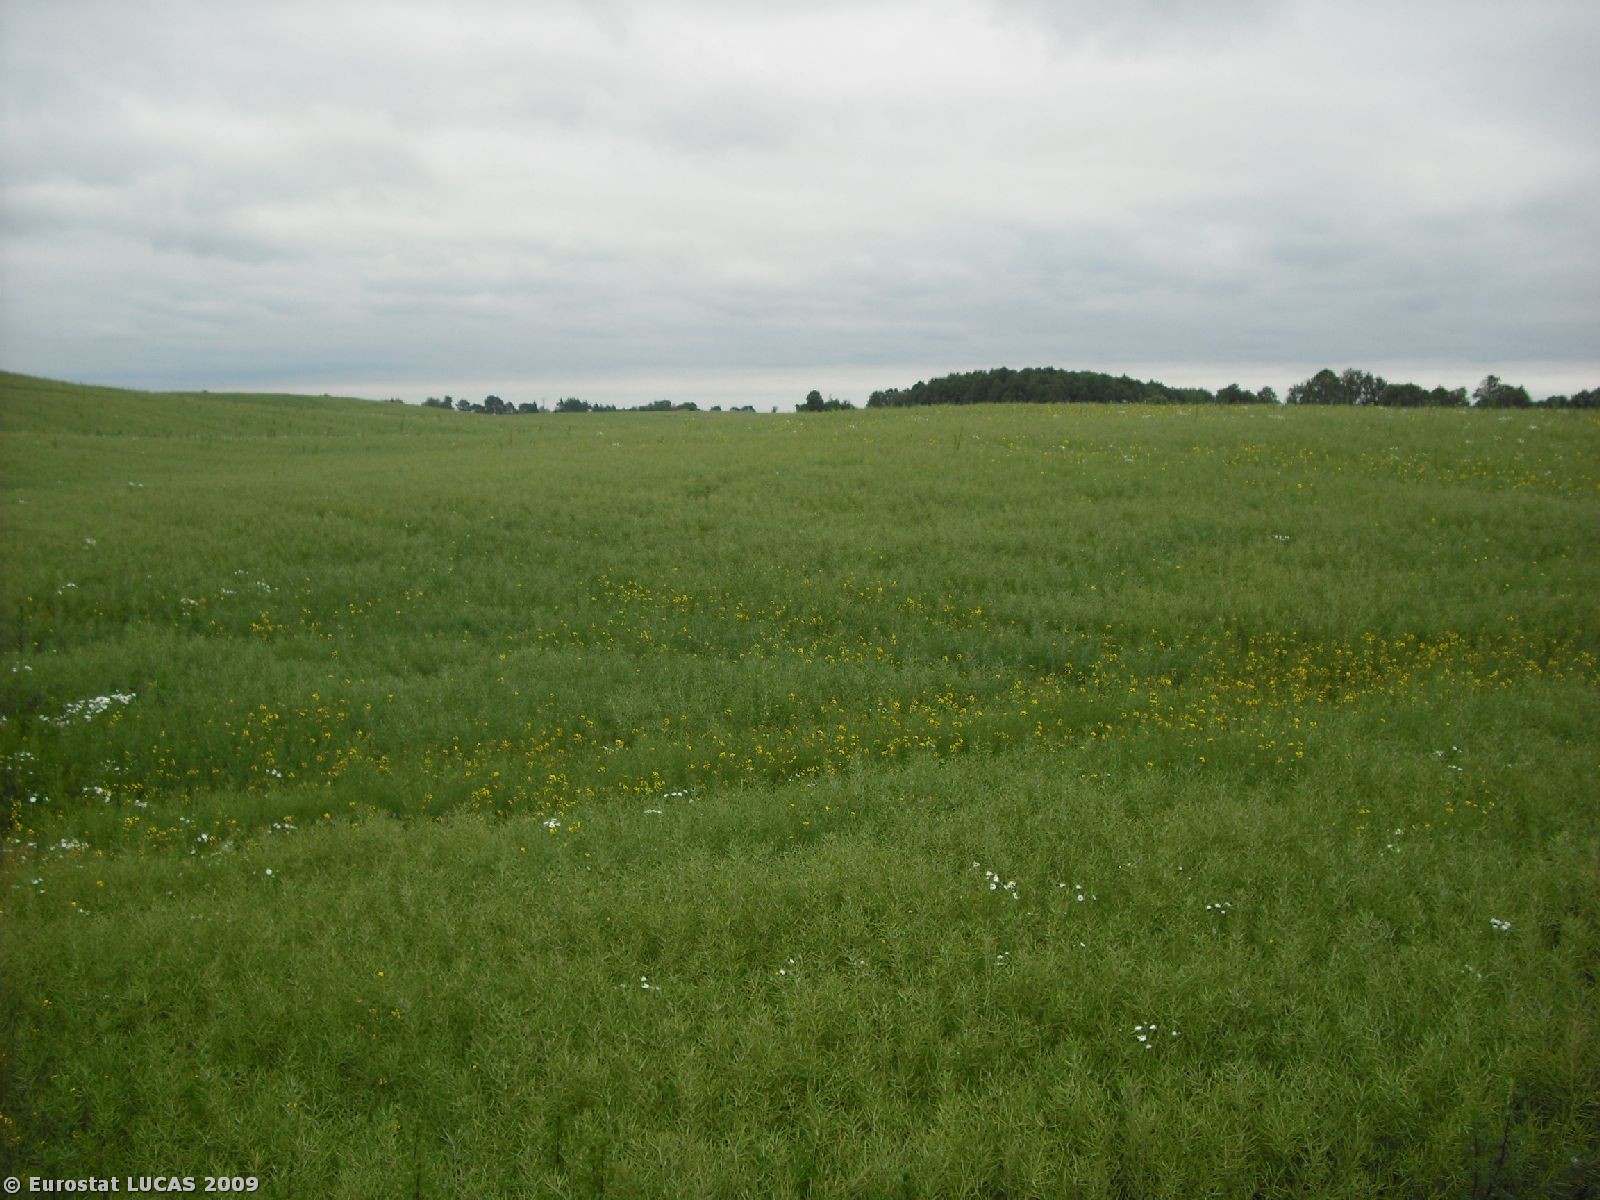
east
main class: Cropland
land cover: Oats
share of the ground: > 75 %
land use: Agriculture (excluding fallow land and kitchen gardens)
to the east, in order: Oats; Fences; Grassland without tree/shrub cover; Abandoned hedges; Ditches and canals; Abandoned hedges; Grassland without tree/shrub cover
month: June
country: PL
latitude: 54.0072
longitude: 22.5002
